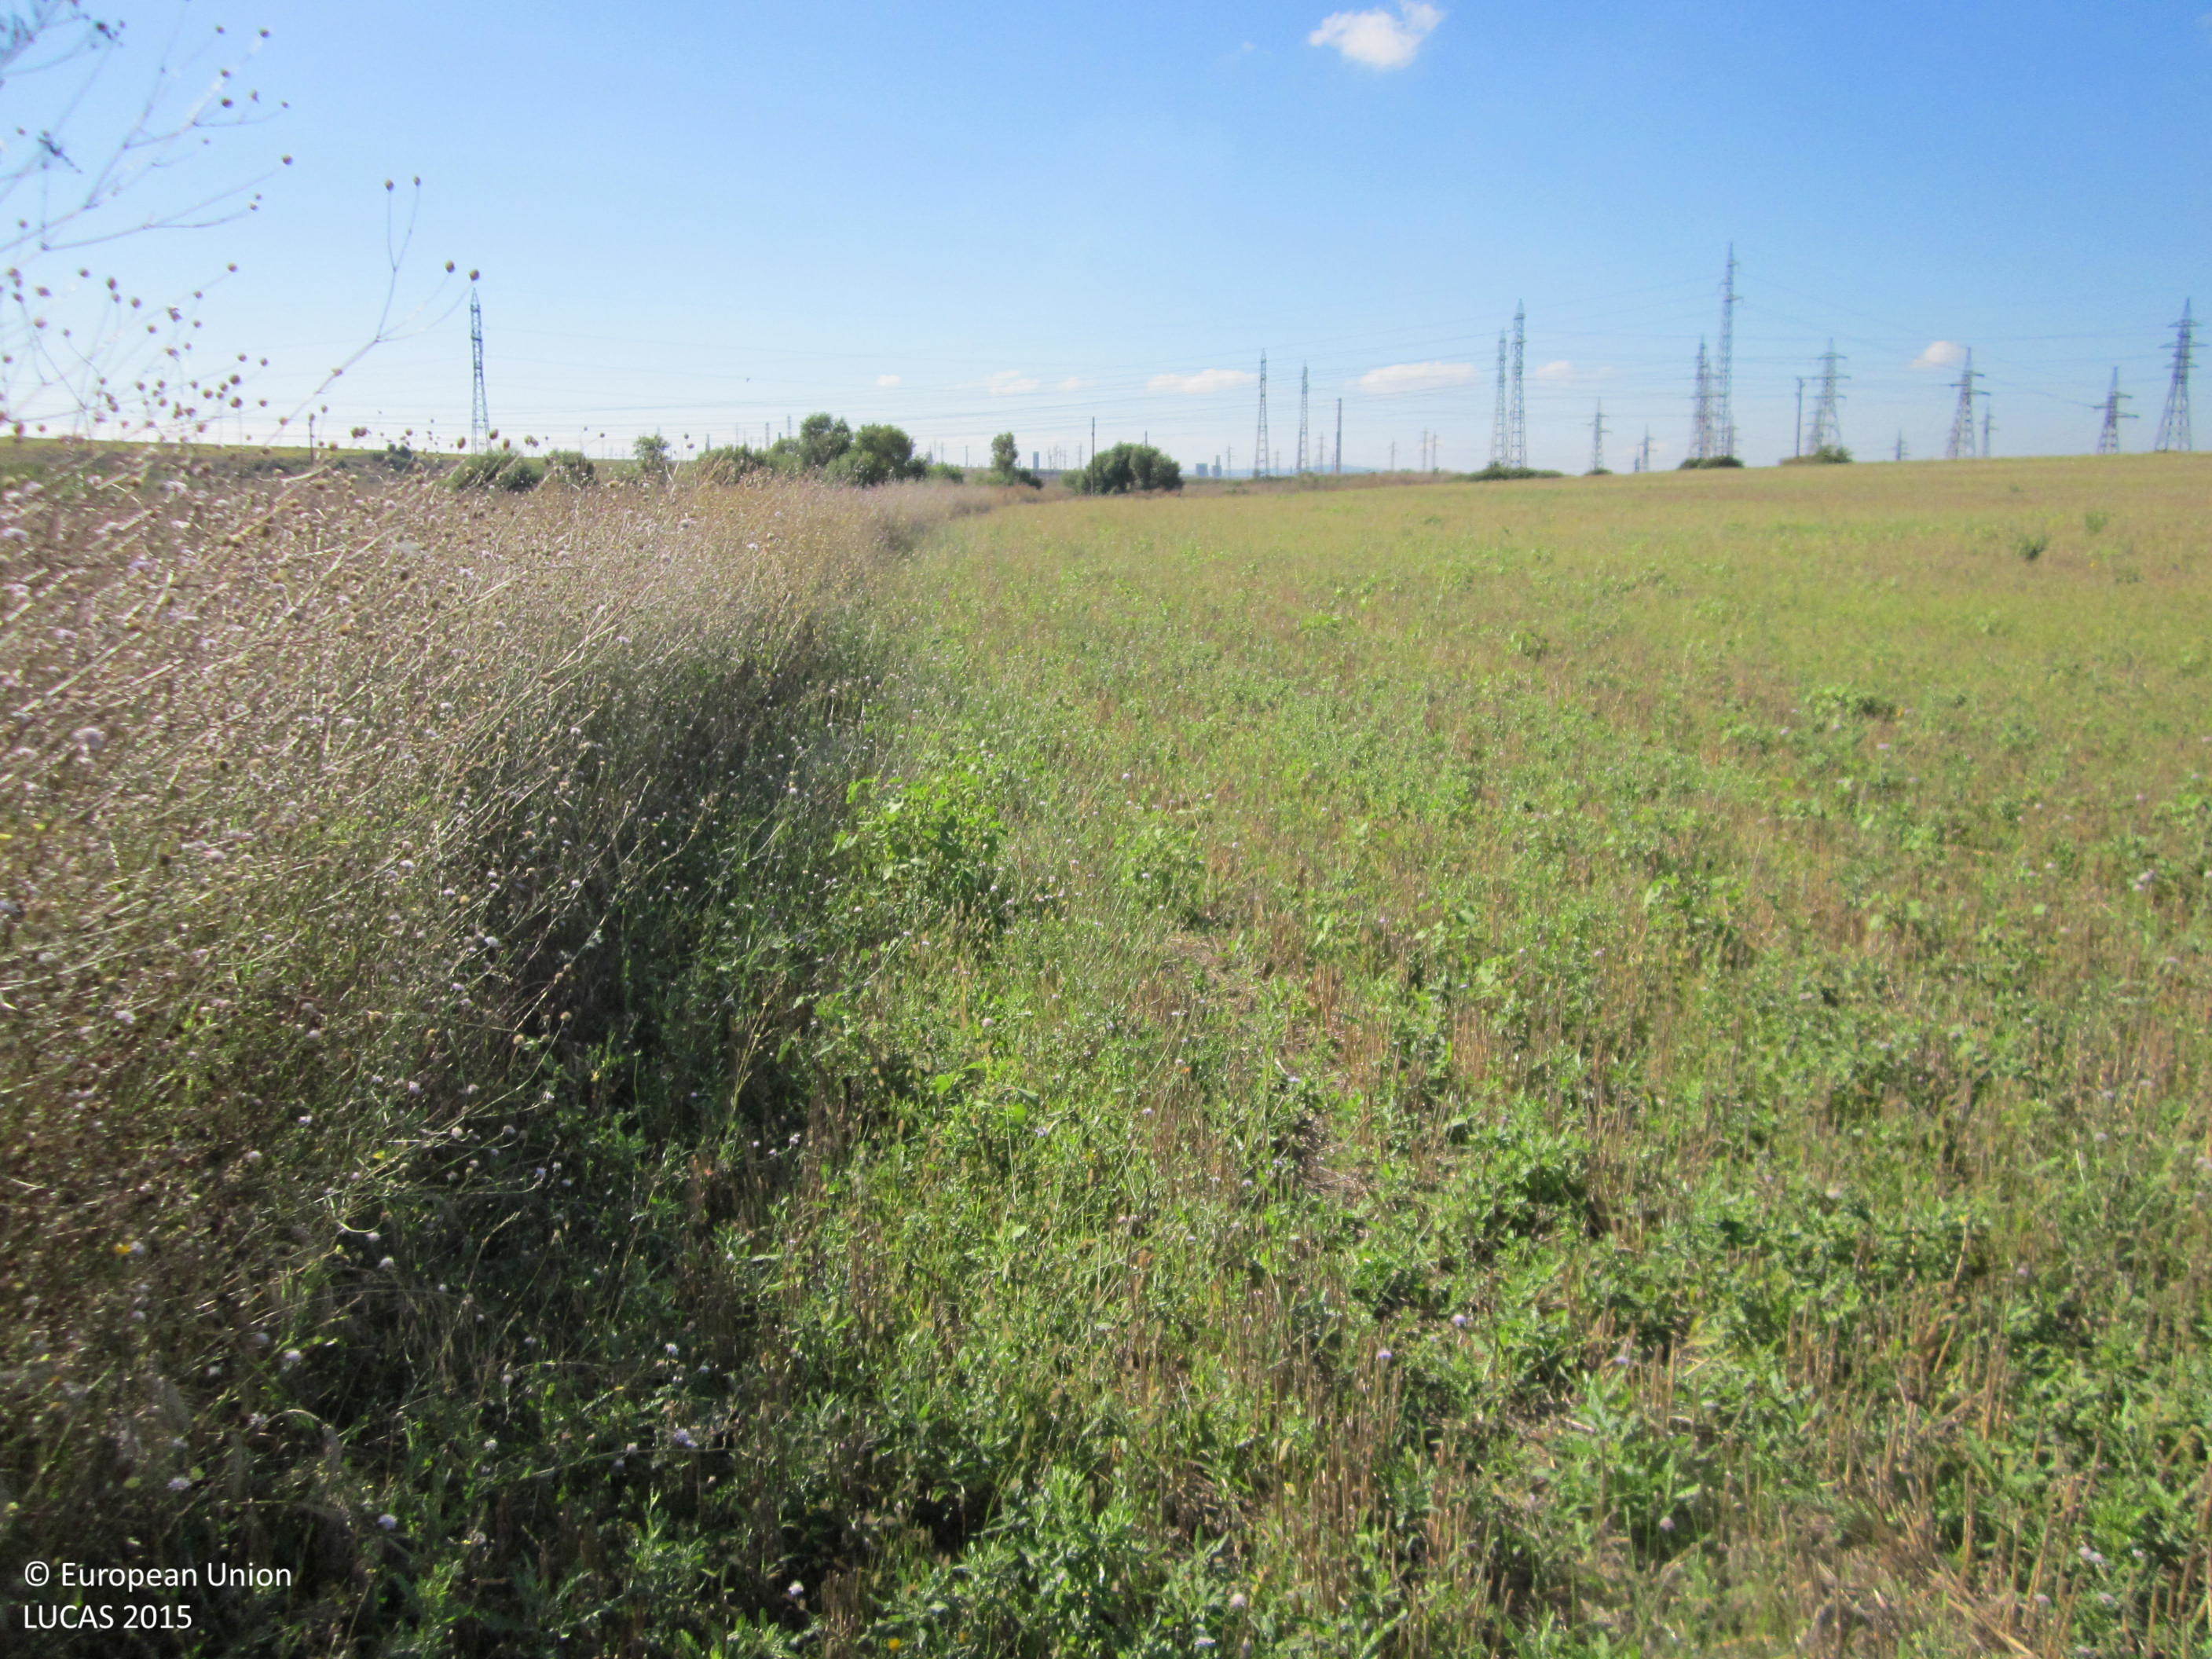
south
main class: Grassland
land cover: Grassland without tree/shrub cover
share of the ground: > 75 %
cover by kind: herbaceous plants 100 %
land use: Semi-natural and natural areas not in use
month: September
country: BG
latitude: 42.5837
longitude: 27.3315
